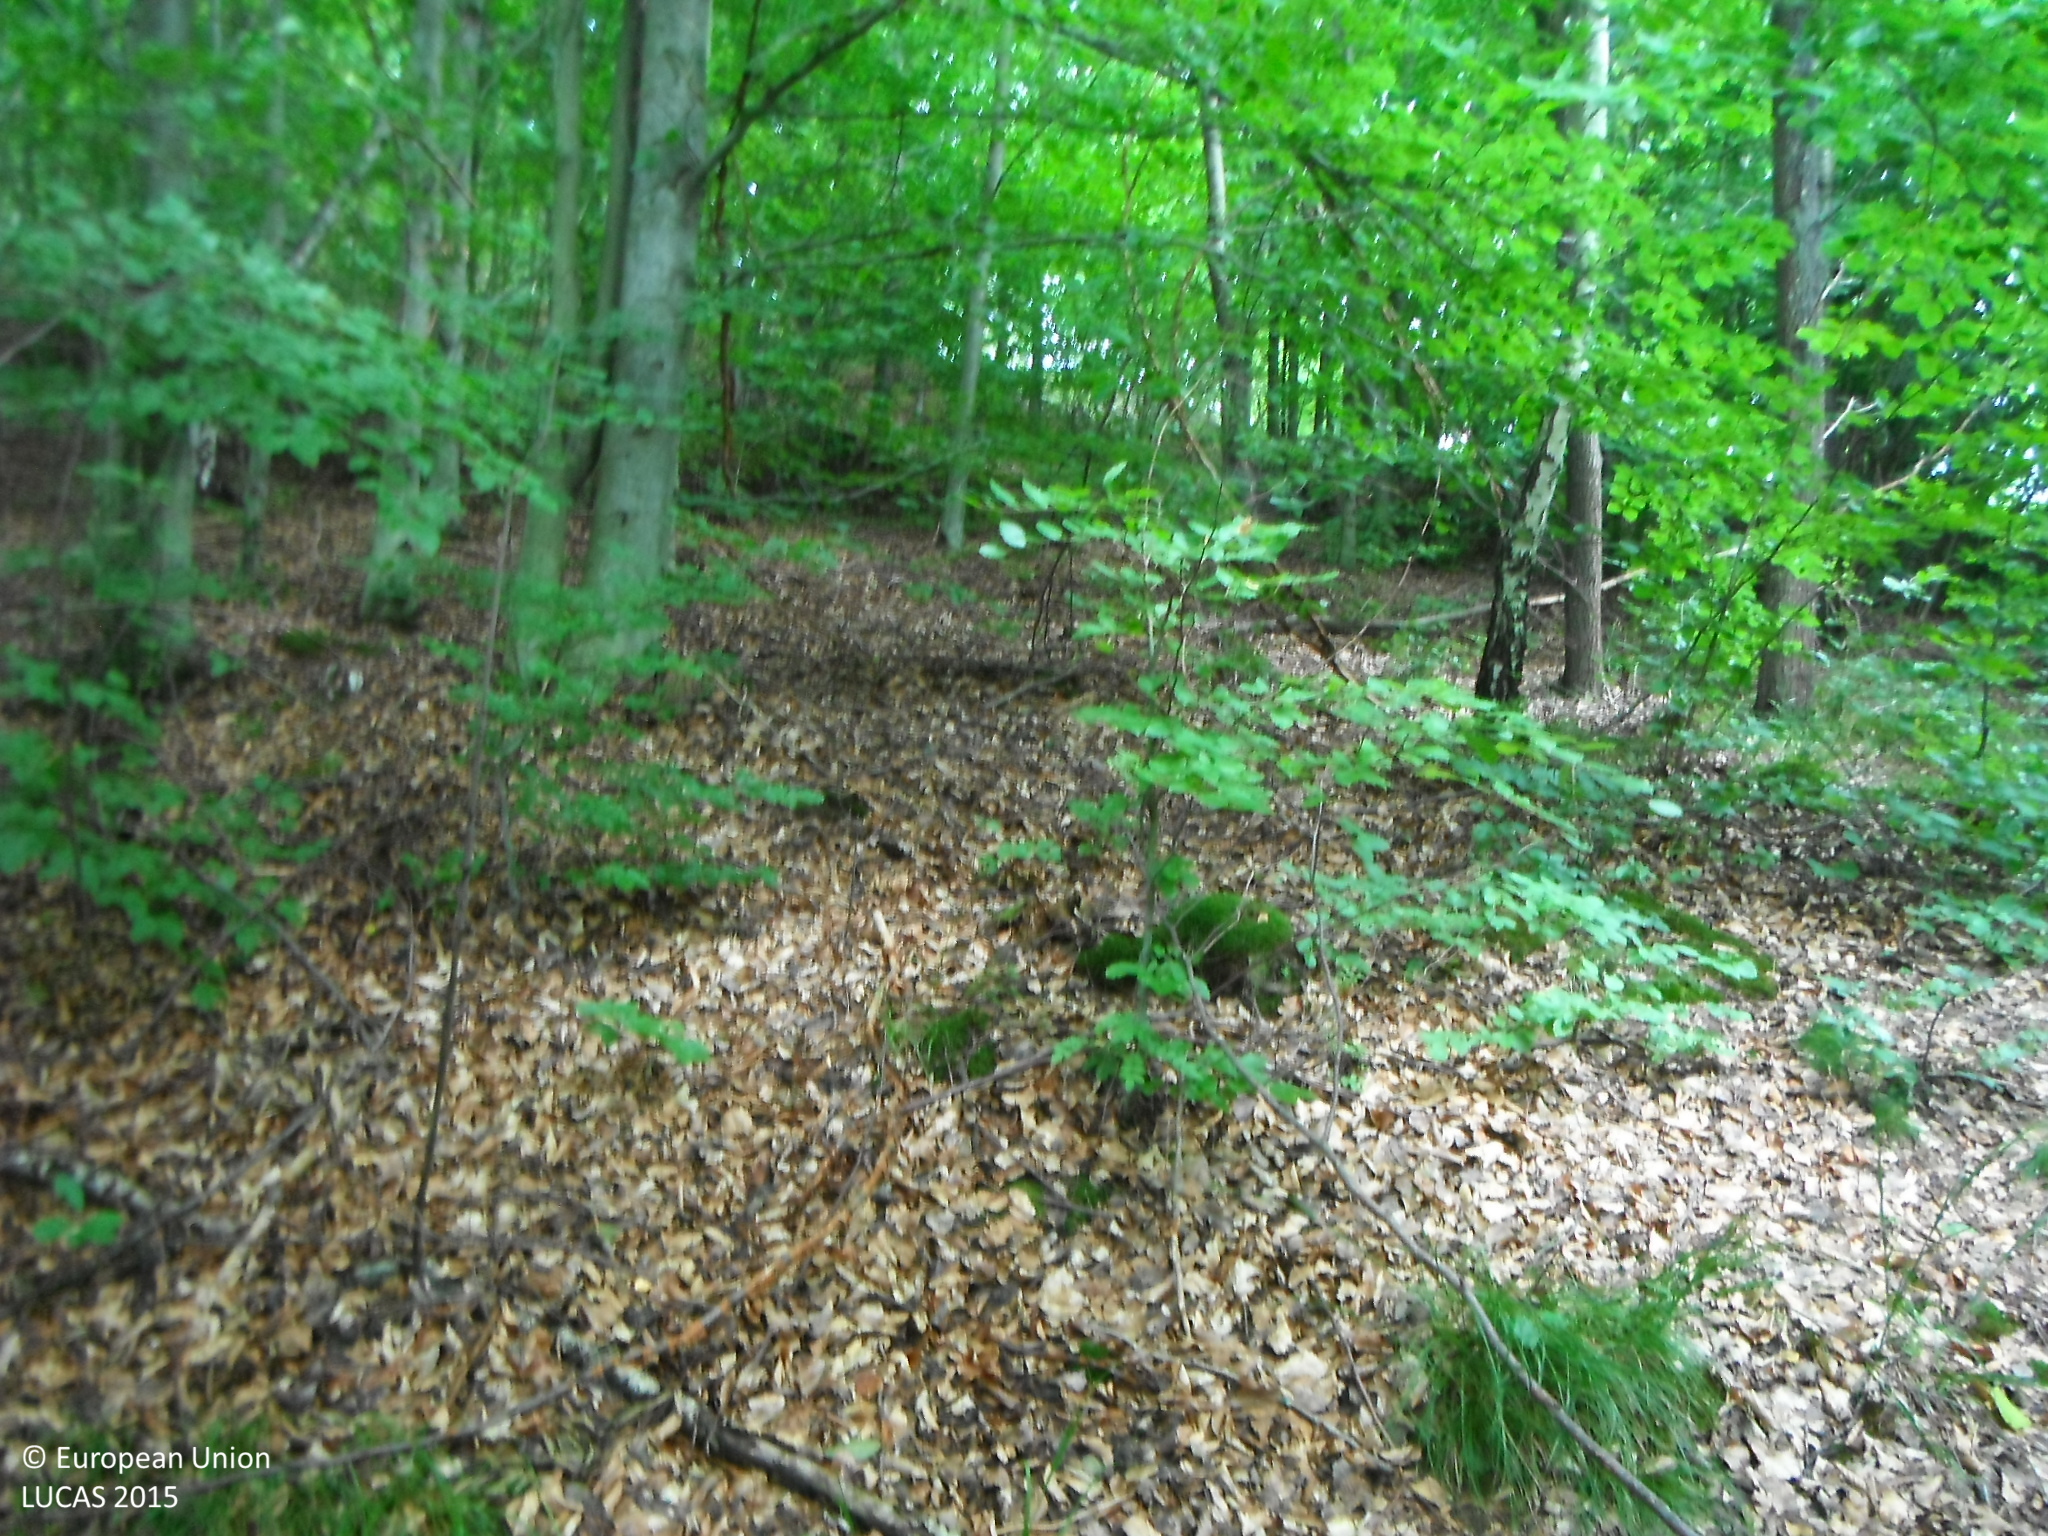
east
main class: Woodland
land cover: Broadleaved woodland
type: beech forest
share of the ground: > 75 %
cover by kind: broadleaved forest trees 100 %
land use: Forestry
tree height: > 5 m
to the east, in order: Broadleaved woodland; Tracks; Broadleaved woodland; Grassland without tree/shrub cover
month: July
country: SK
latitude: 48.8307
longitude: 20.8424
